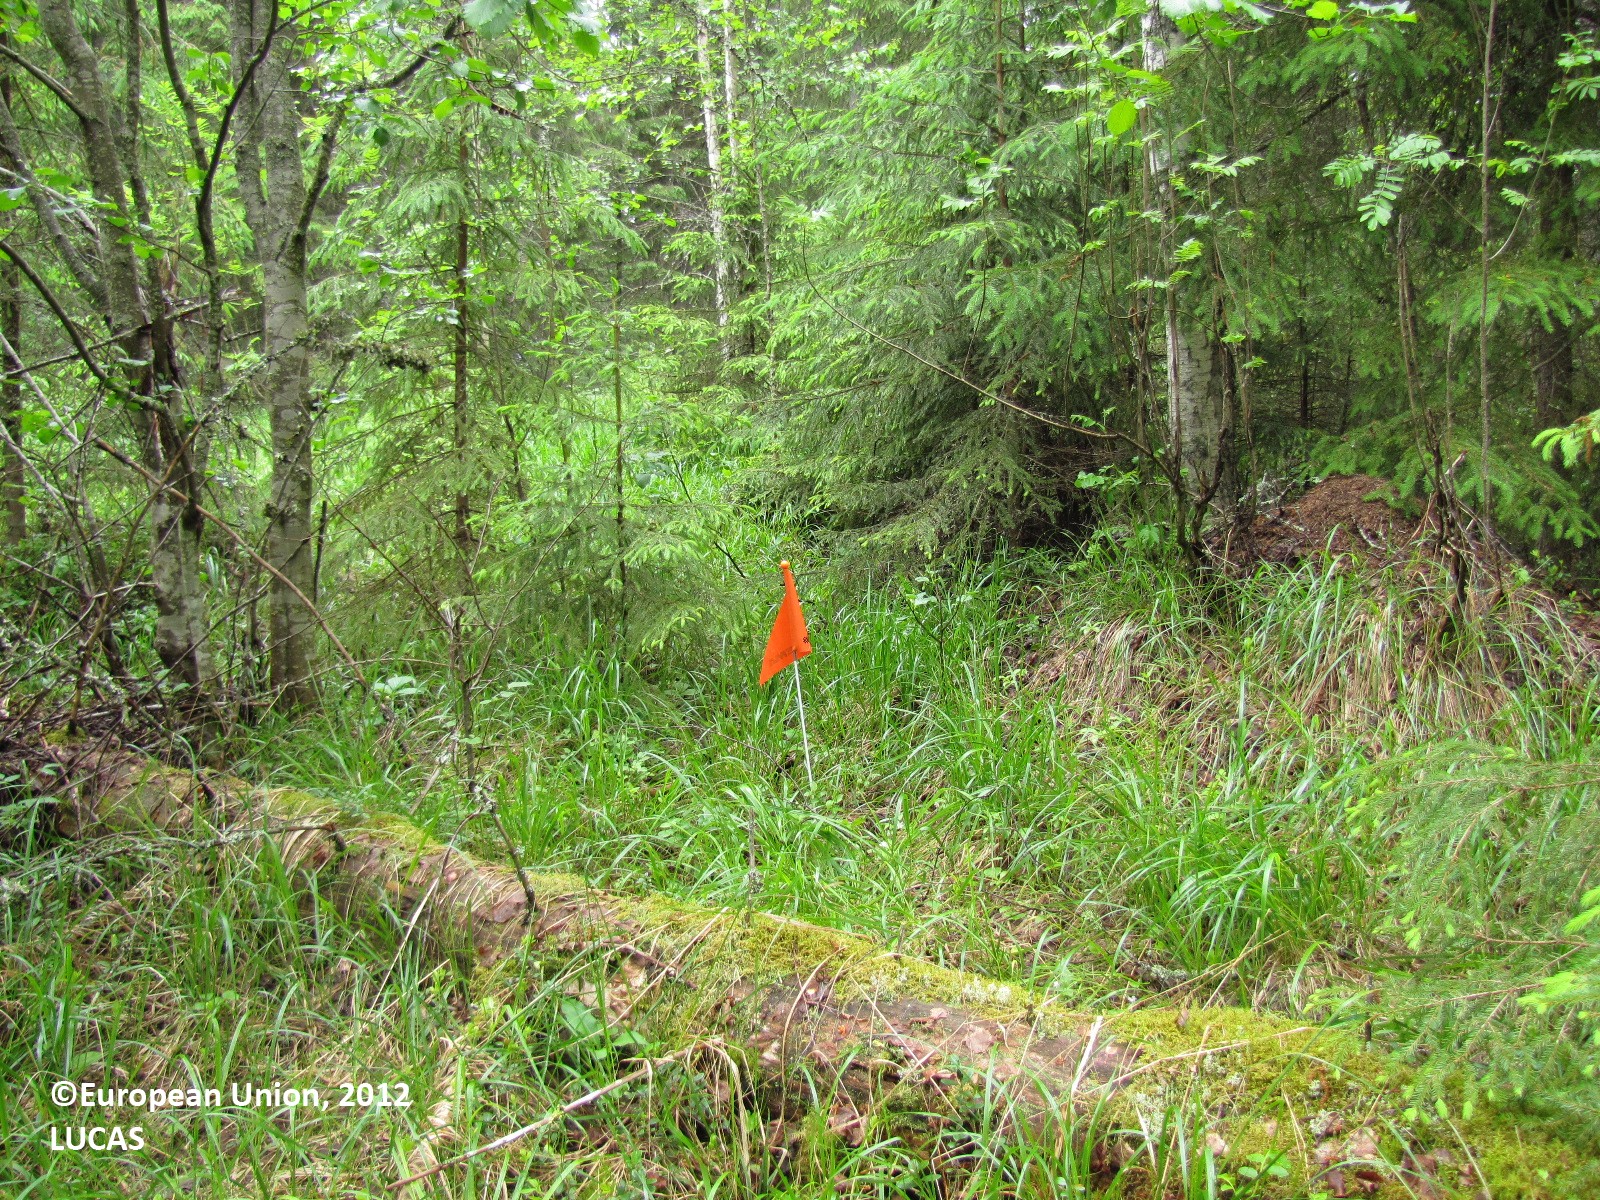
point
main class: Woodland
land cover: Spruce dominated coniferous woodland
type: boreal forest
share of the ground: 50 - 75 %
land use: Forestry
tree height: > 5 m
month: June
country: FI
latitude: 61.5516
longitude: 24.7244
